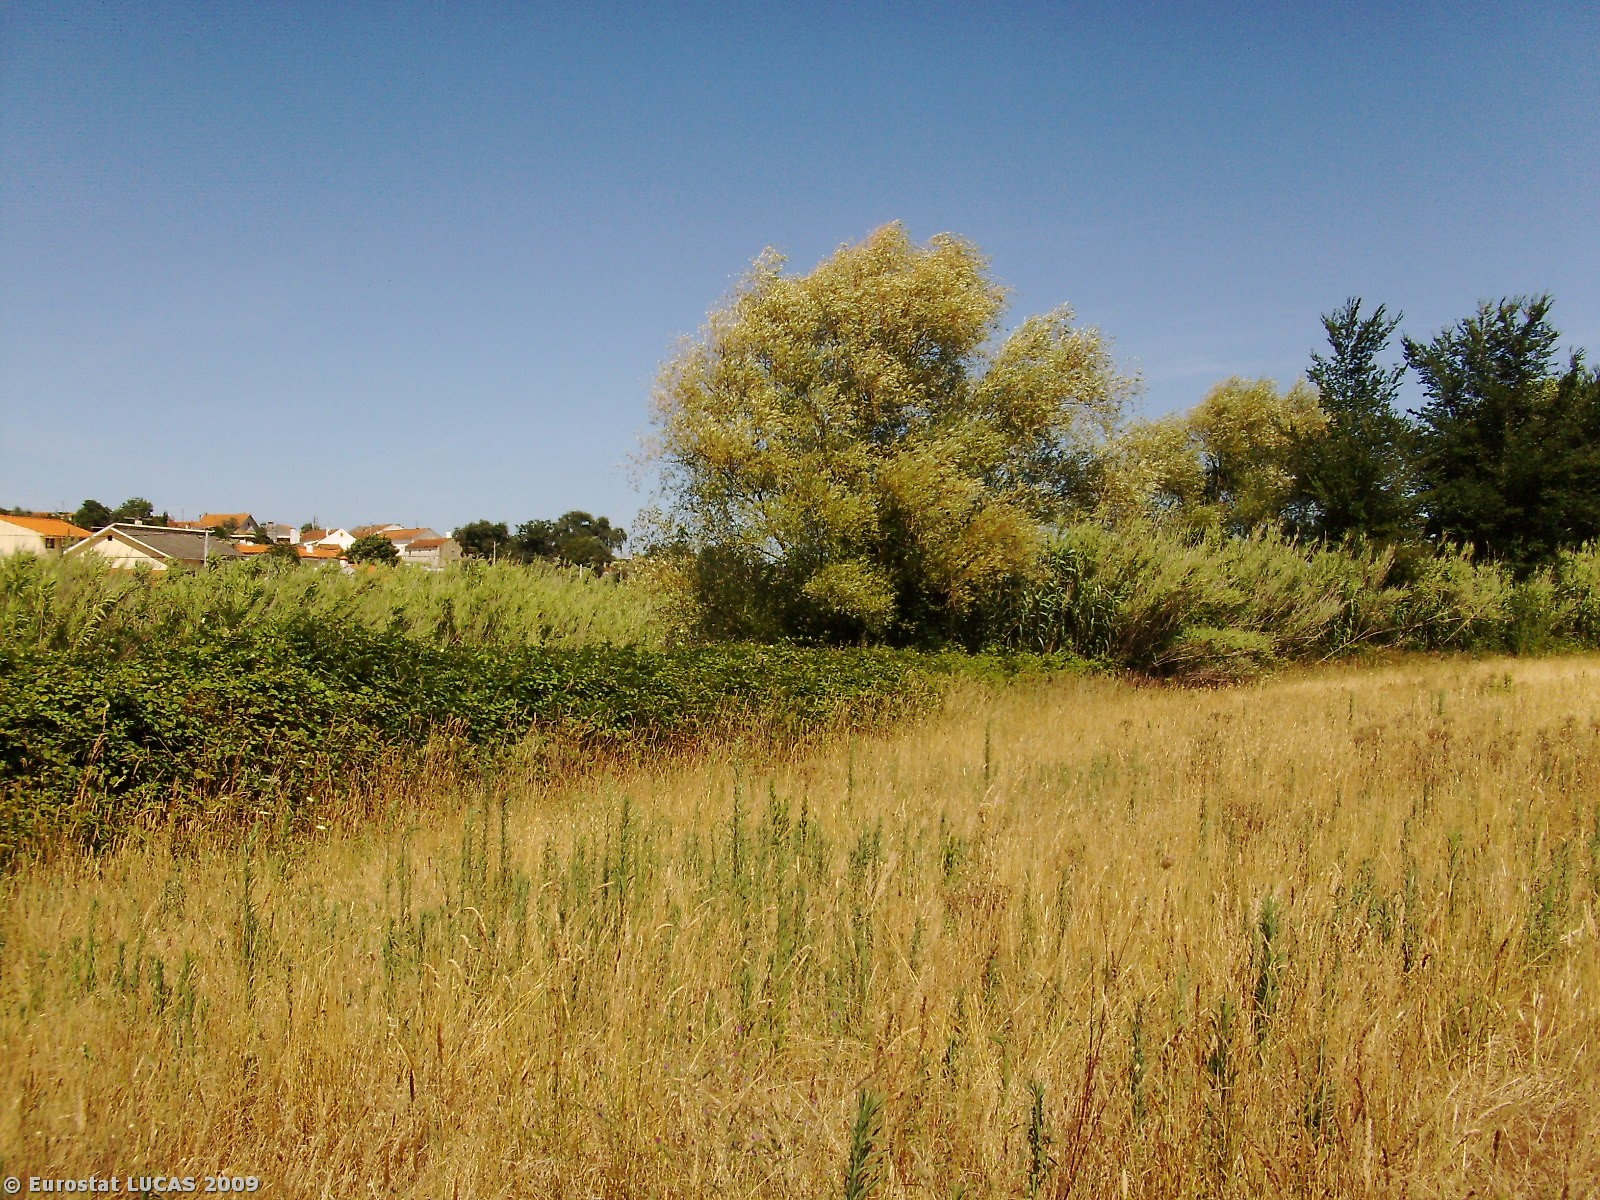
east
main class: Grassland
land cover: Spontaneously vegetated surfaces
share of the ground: > 75 %
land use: Fallow land
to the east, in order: Spontaneously vegetated surfaces; Shrubland with sparse tree cover; Rivers and streams; Shrubland with sparse tree cover; Arable land (only in case pi); Broadleaved woodland
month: July
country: PT
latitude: 39.6769
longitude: -8.8683
